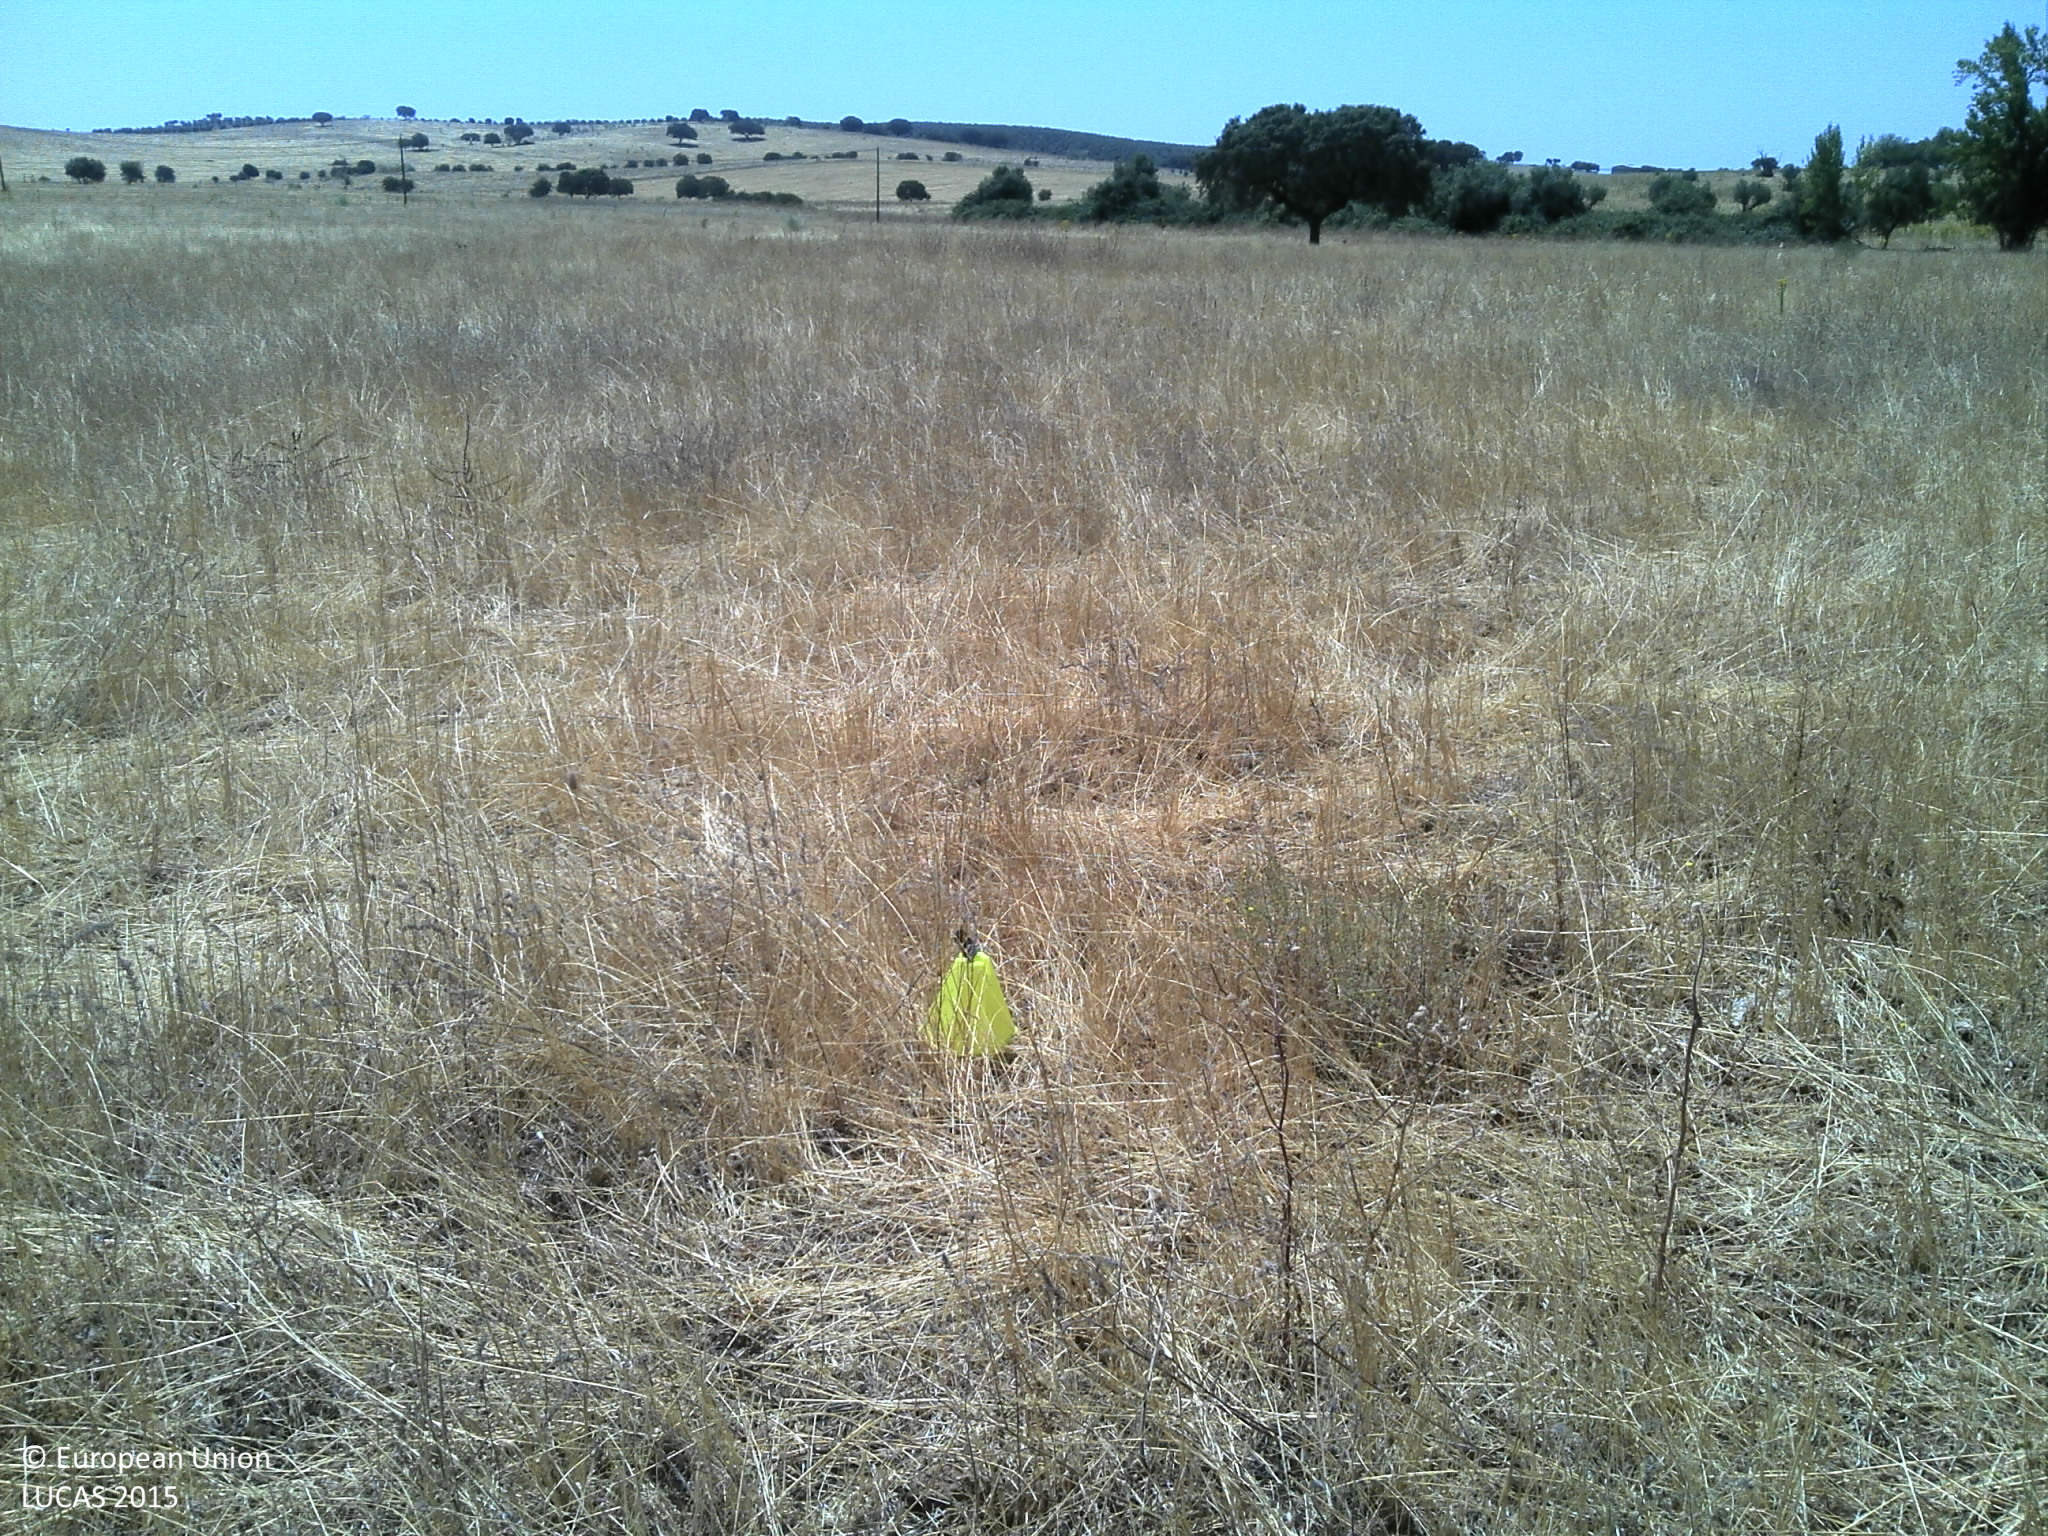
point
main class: Grassland
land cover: Grassland without tree/shrub cover
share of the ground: 50 - 75 %
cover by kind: herbaceous plants 75 %, unconsolidated bare surface 25 %
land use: Agriculture (excluding fallow land and kitchen gardens)
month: July
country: PT
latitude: 38.4665
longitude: -7.4593
